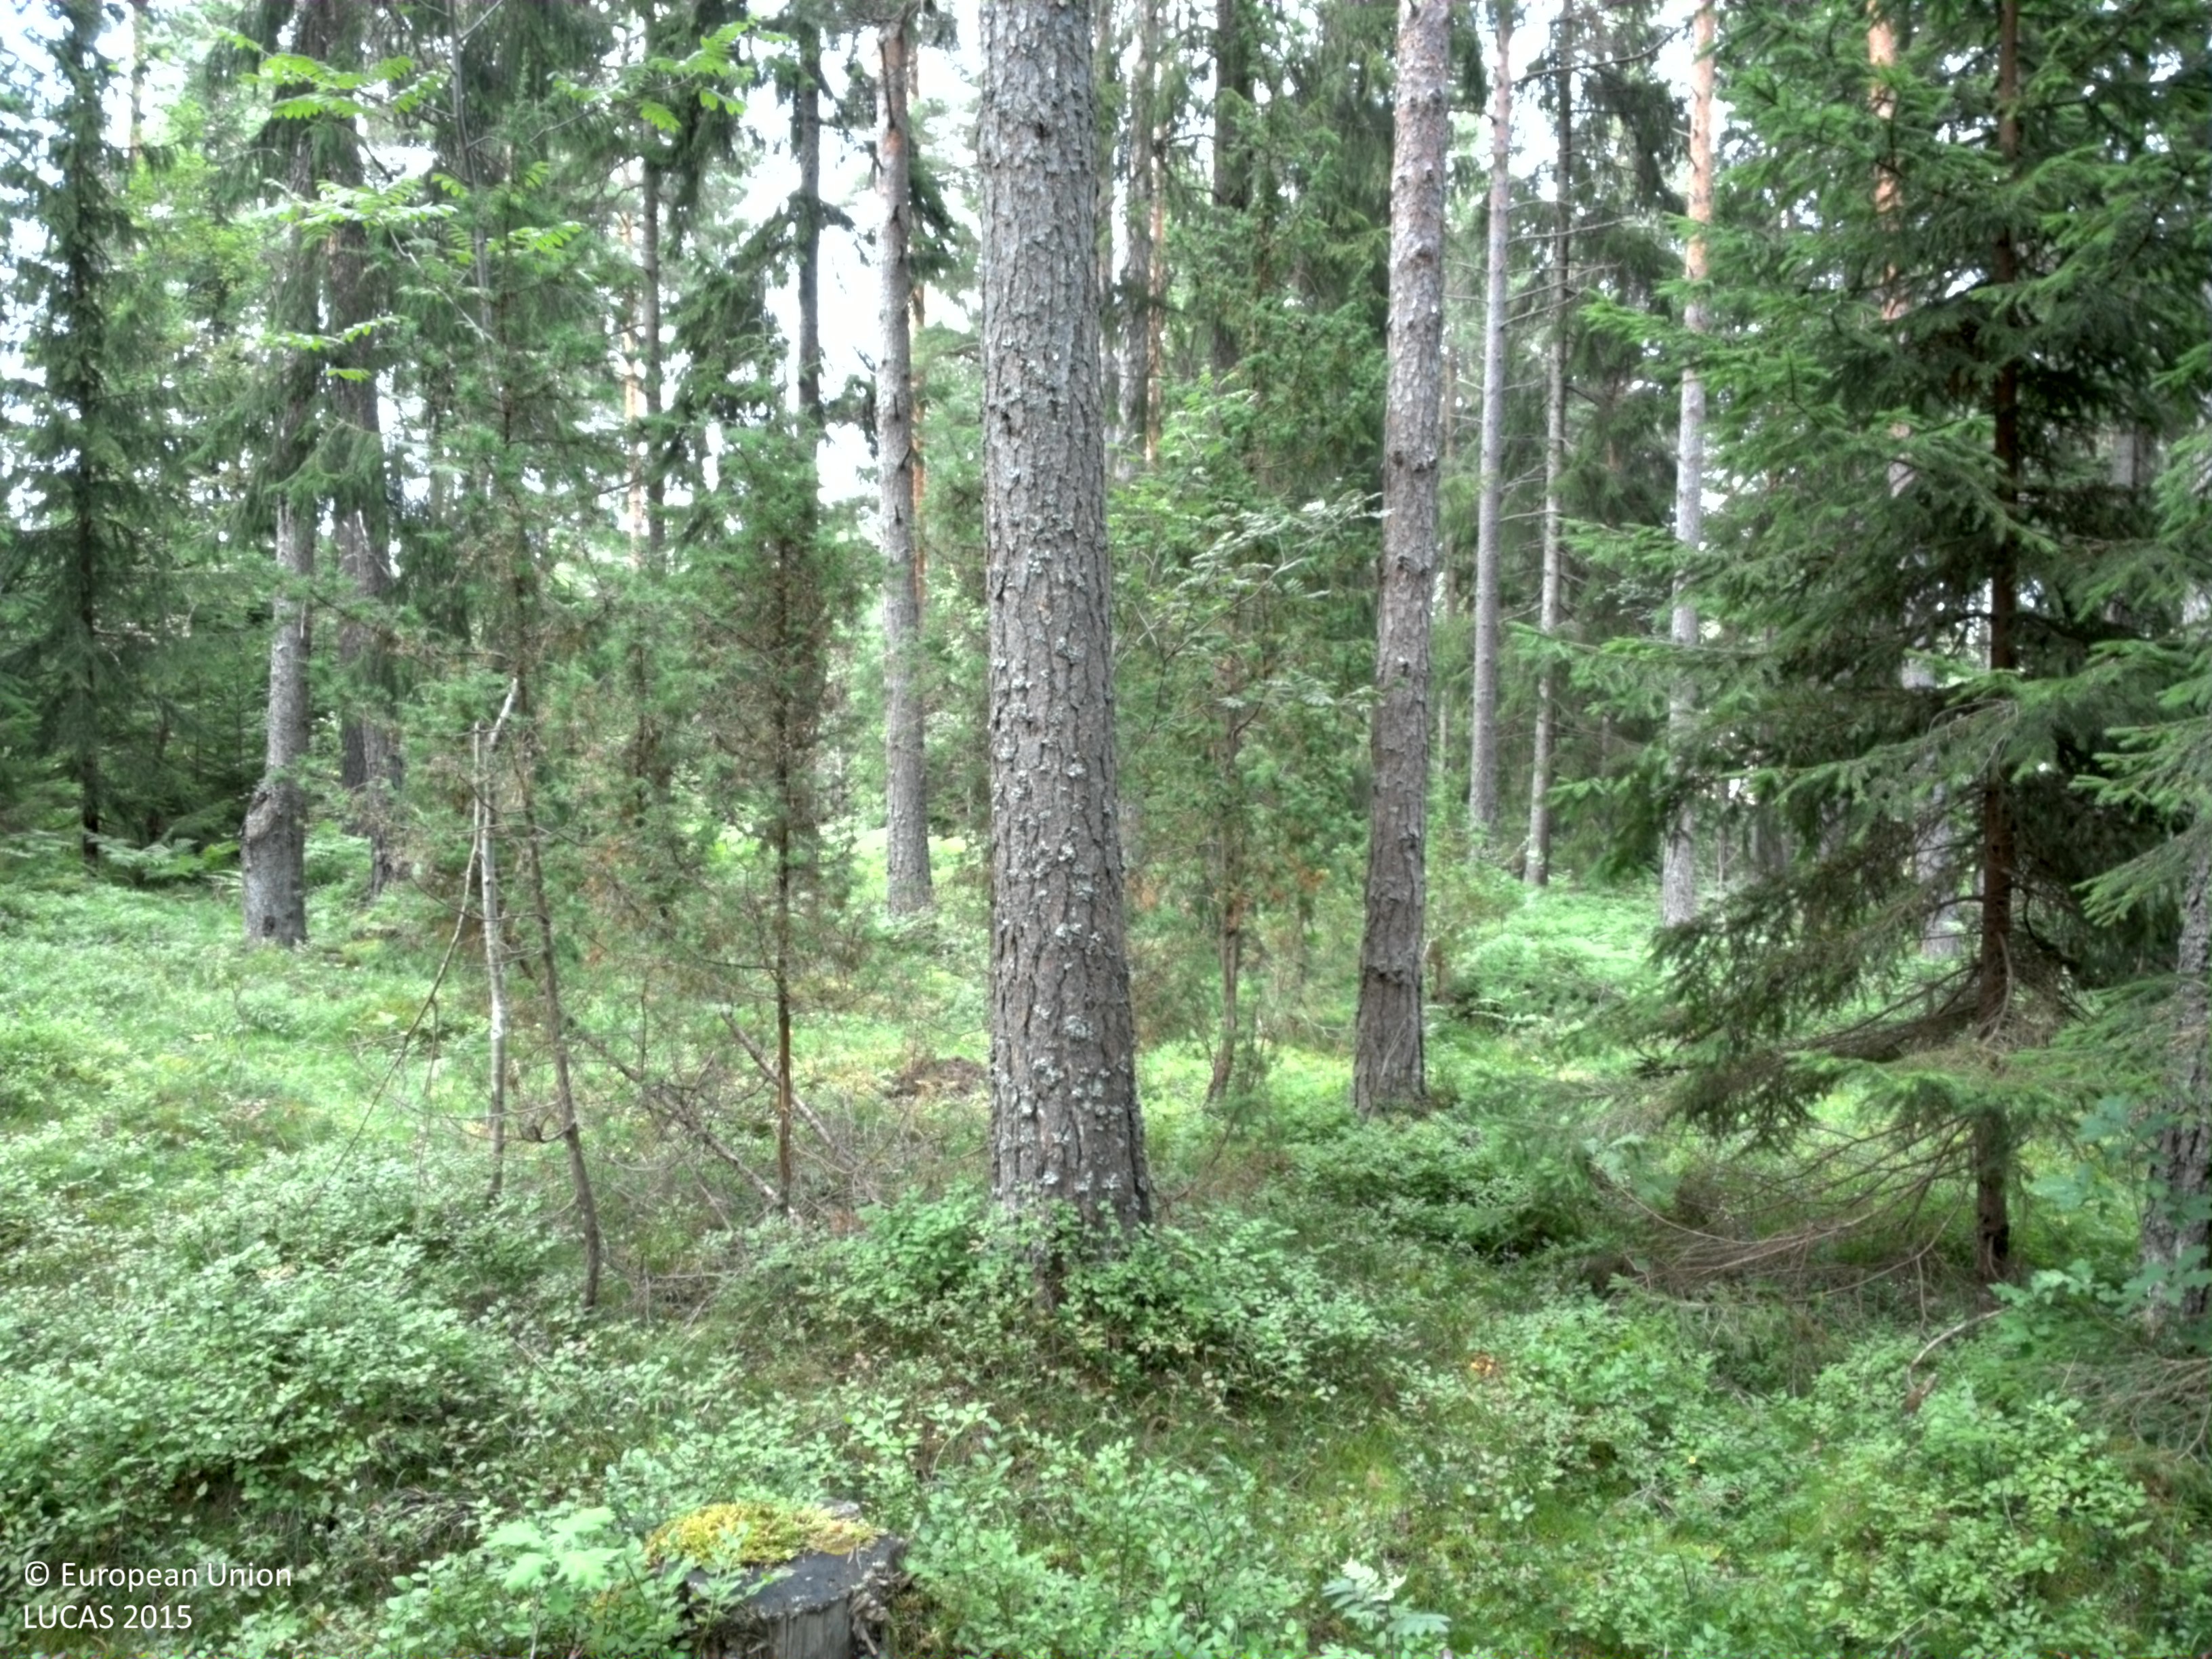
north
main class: Woodland
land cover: Spruce dominated coniferous woodland
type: boreal forest
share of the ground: 50 - 75 %
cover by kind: coniferous forest trees 70 %, shrubs 10 %, lichens and mosses 10 %, broadleaved forest trees 5 %, herbaceous plants 5 %
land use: Forestry
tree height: > 5 m
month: July
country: SE
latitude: 59.5187
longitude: 18.6079
